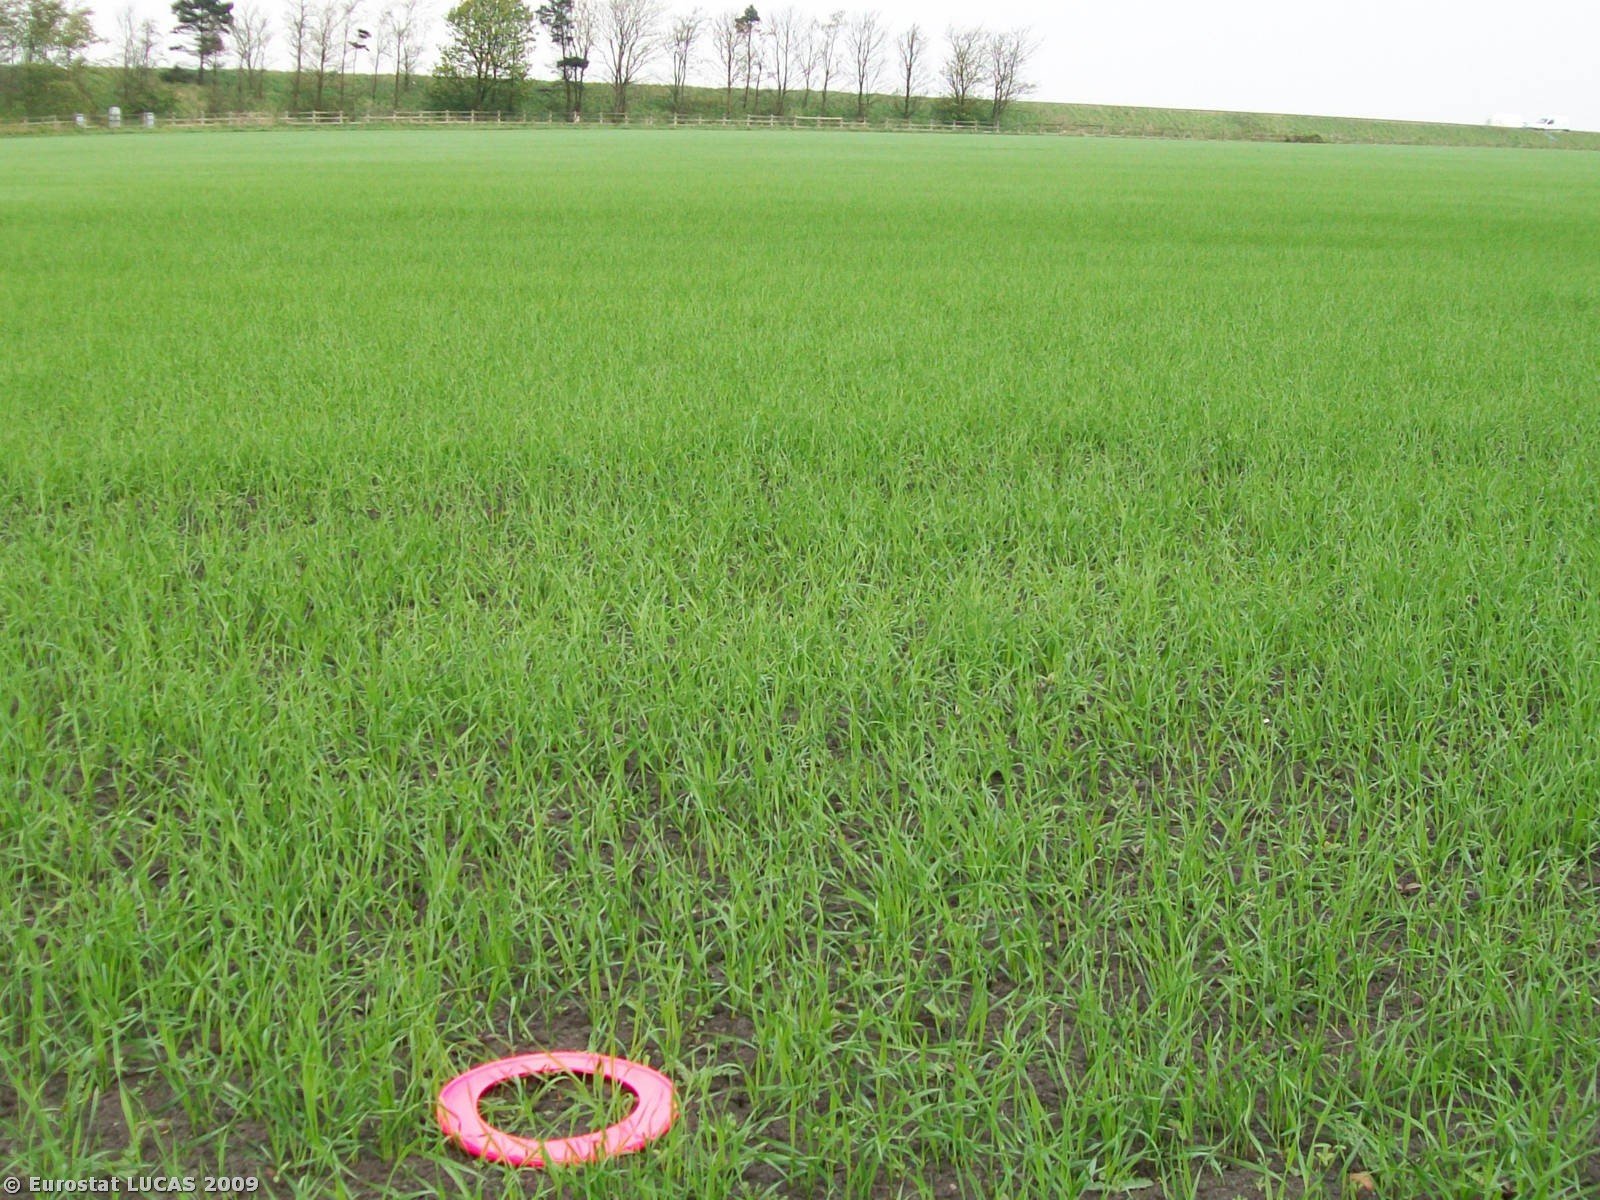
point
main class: Cropland
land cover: Common wheat
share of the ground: 50 - 75 %
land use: Agriculture (excluding fallow land and kitchen gardens)
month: April
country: GB
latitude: 53.5366
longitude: -2.8207
